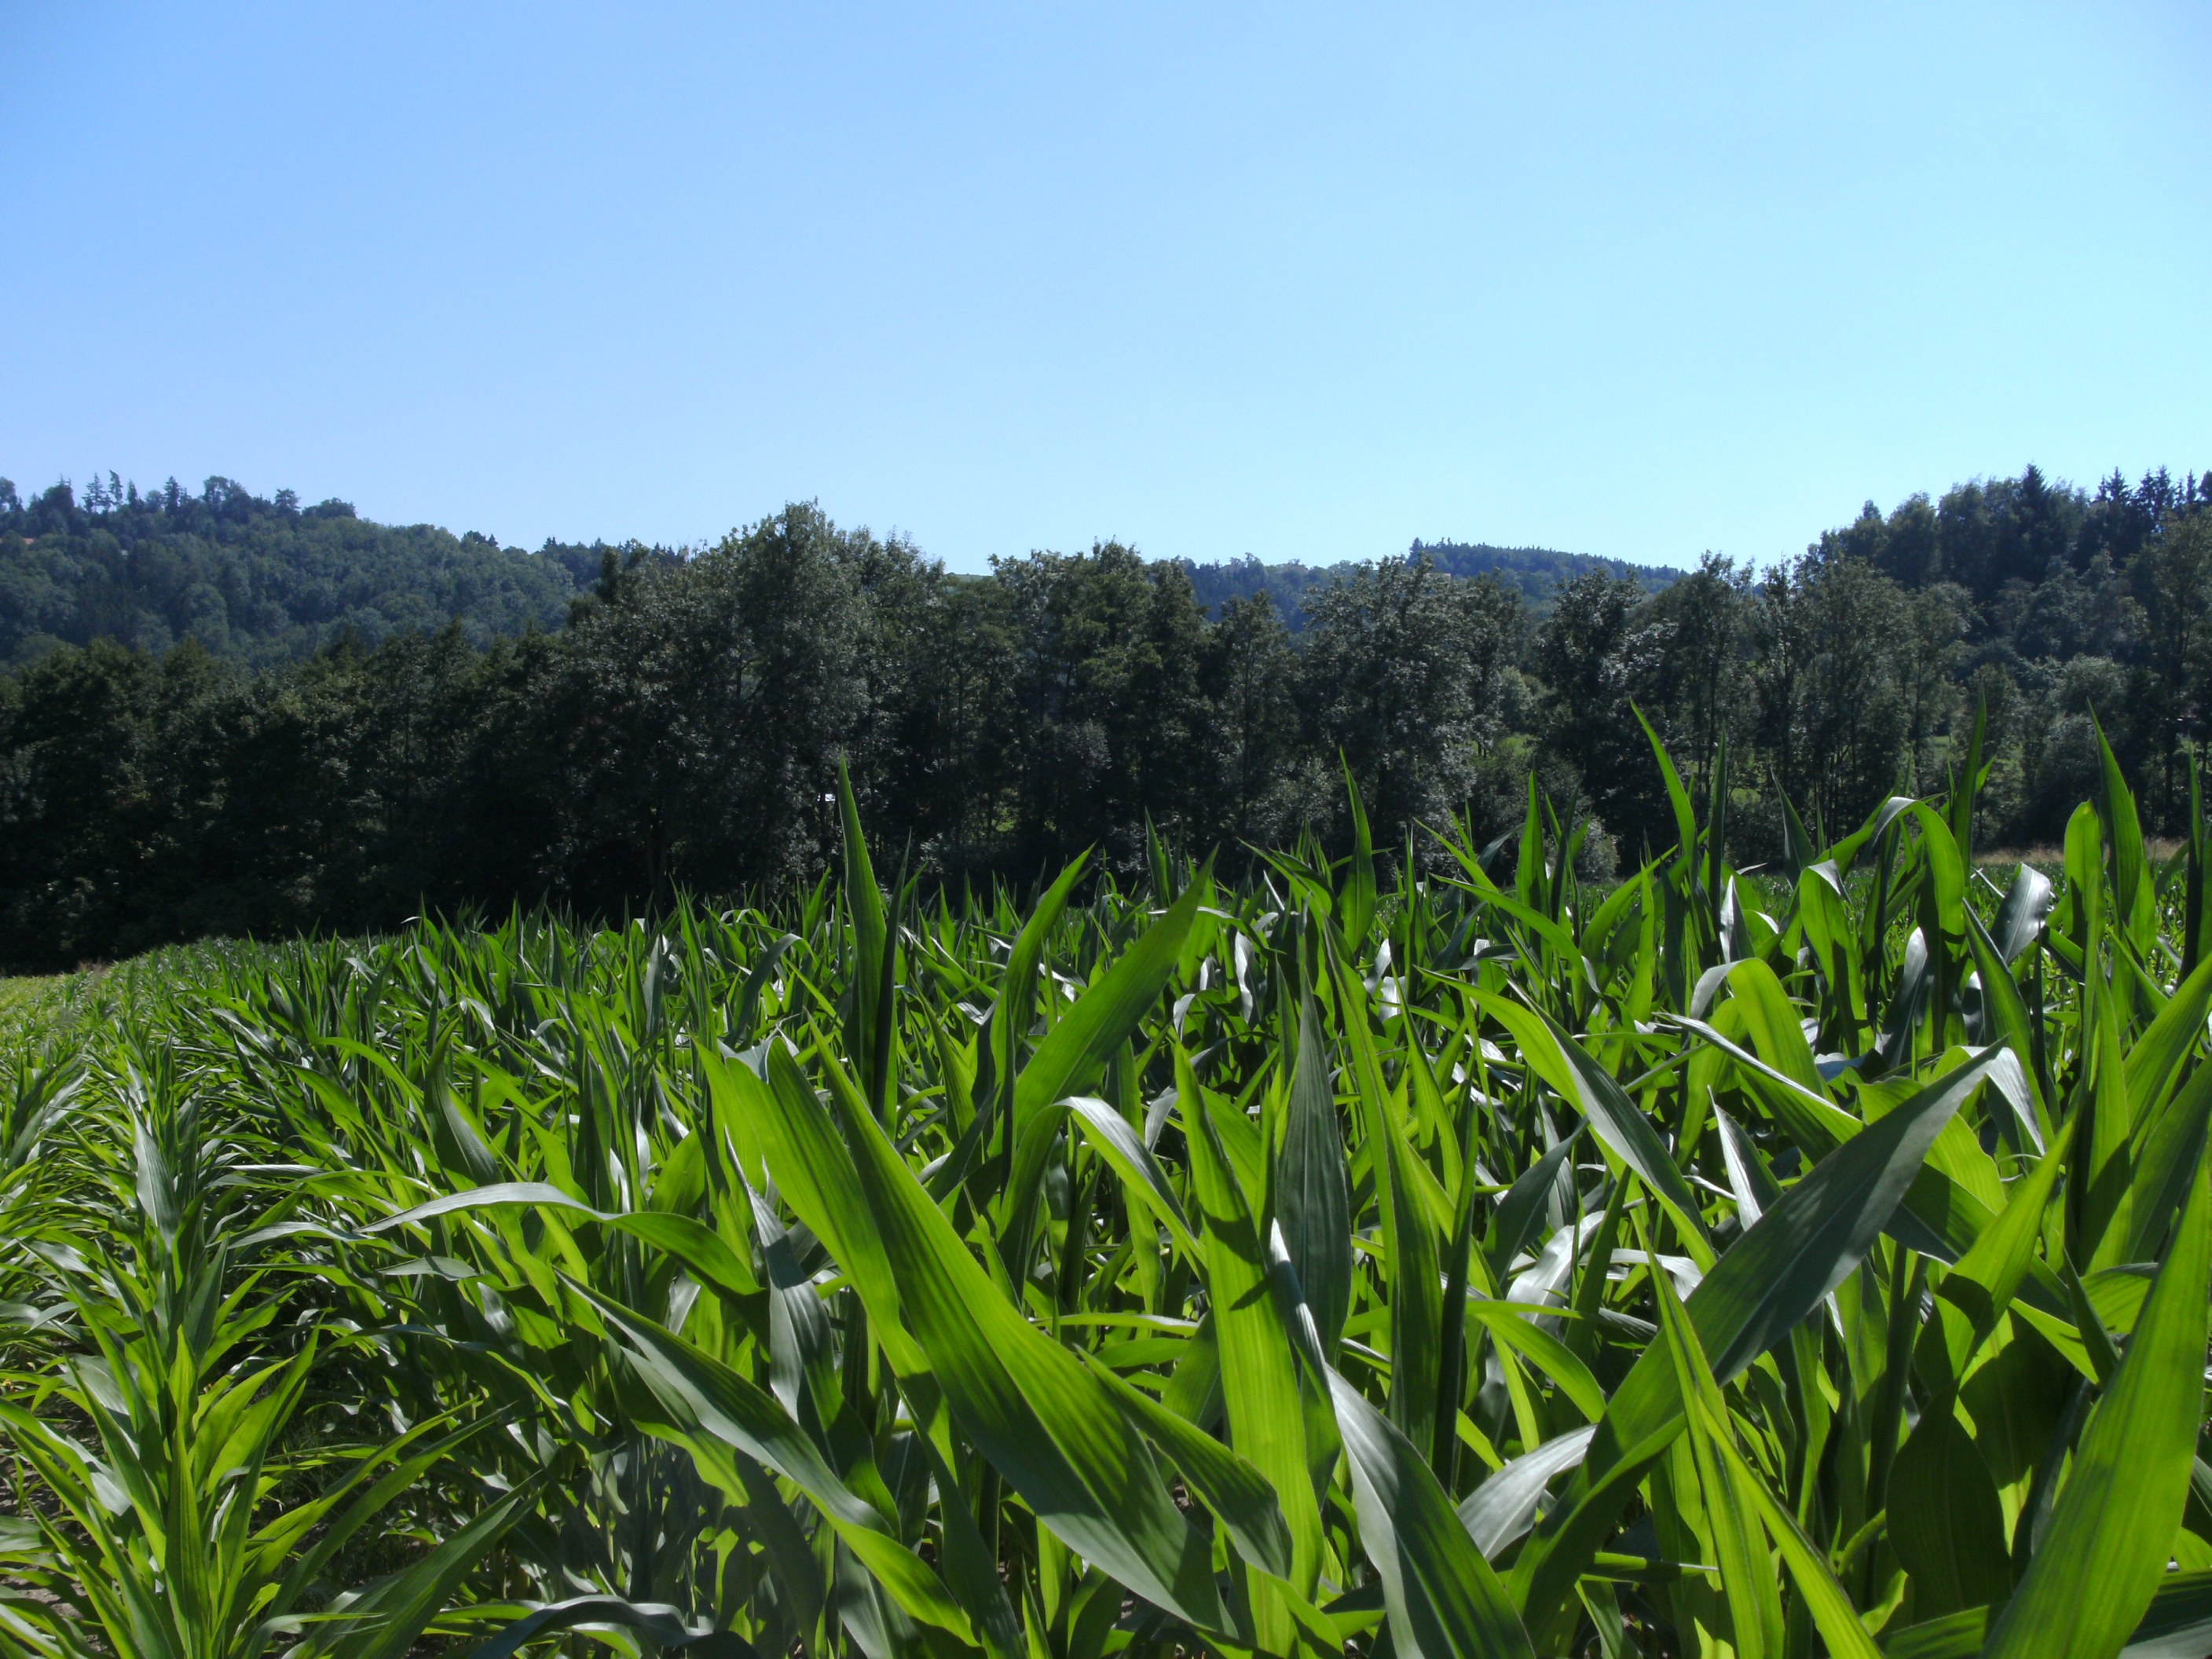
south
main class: Cropland
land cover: Maize
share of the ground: 50 - 75 %
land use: Agriculture (excluding fallow land and kitchen gardens)
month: July
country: AT
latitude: 48.2581
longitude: 14.0272
